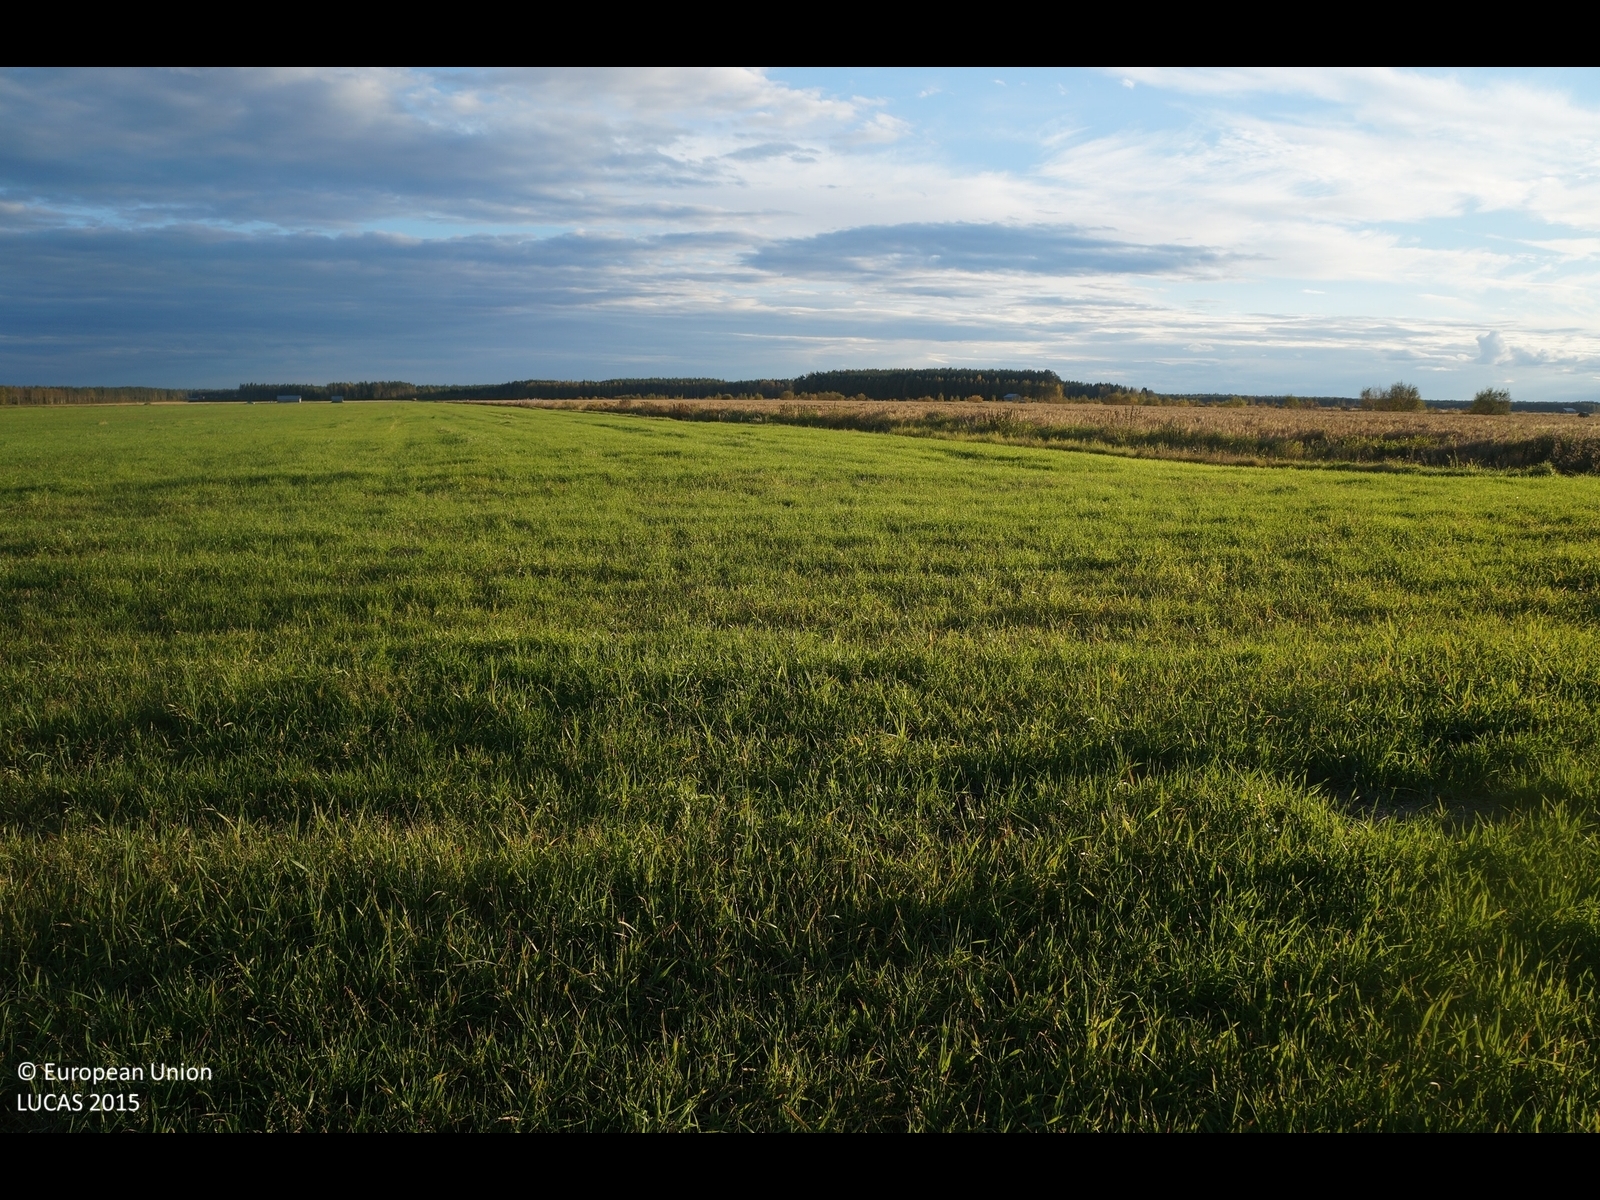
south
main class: Cropland
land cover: Temporary grasslands
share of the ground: > 75 %
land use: Agriculture (excluding fallow land and kitchen gardens)
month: September
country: FI
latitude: 64.1785
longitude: 24.2036
